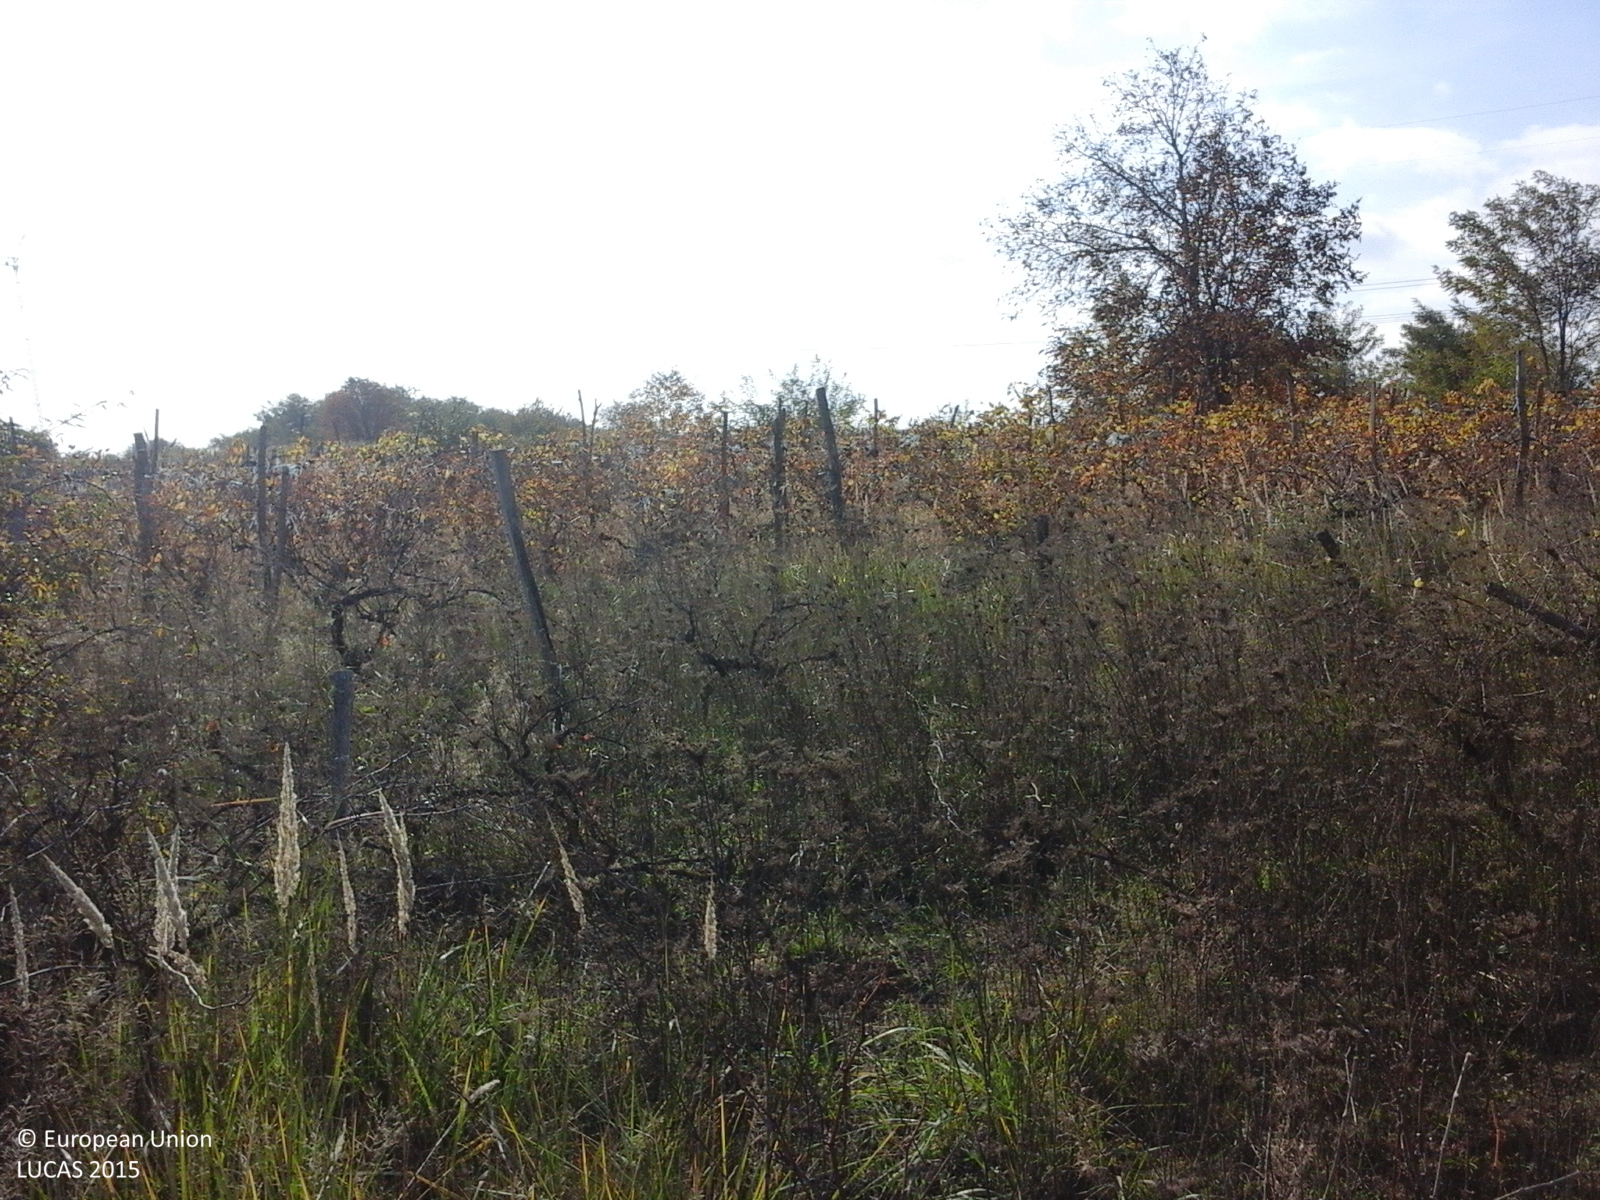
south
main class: Cropland
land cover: Vineyards
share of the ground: > 75 %
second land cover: Spontaneously vegetated surfaces
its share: > 75 %
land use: Agriculture (excluding fallow land and kitchen gardens)
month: October
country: RO
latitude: 45.9874
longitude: 27.1231
